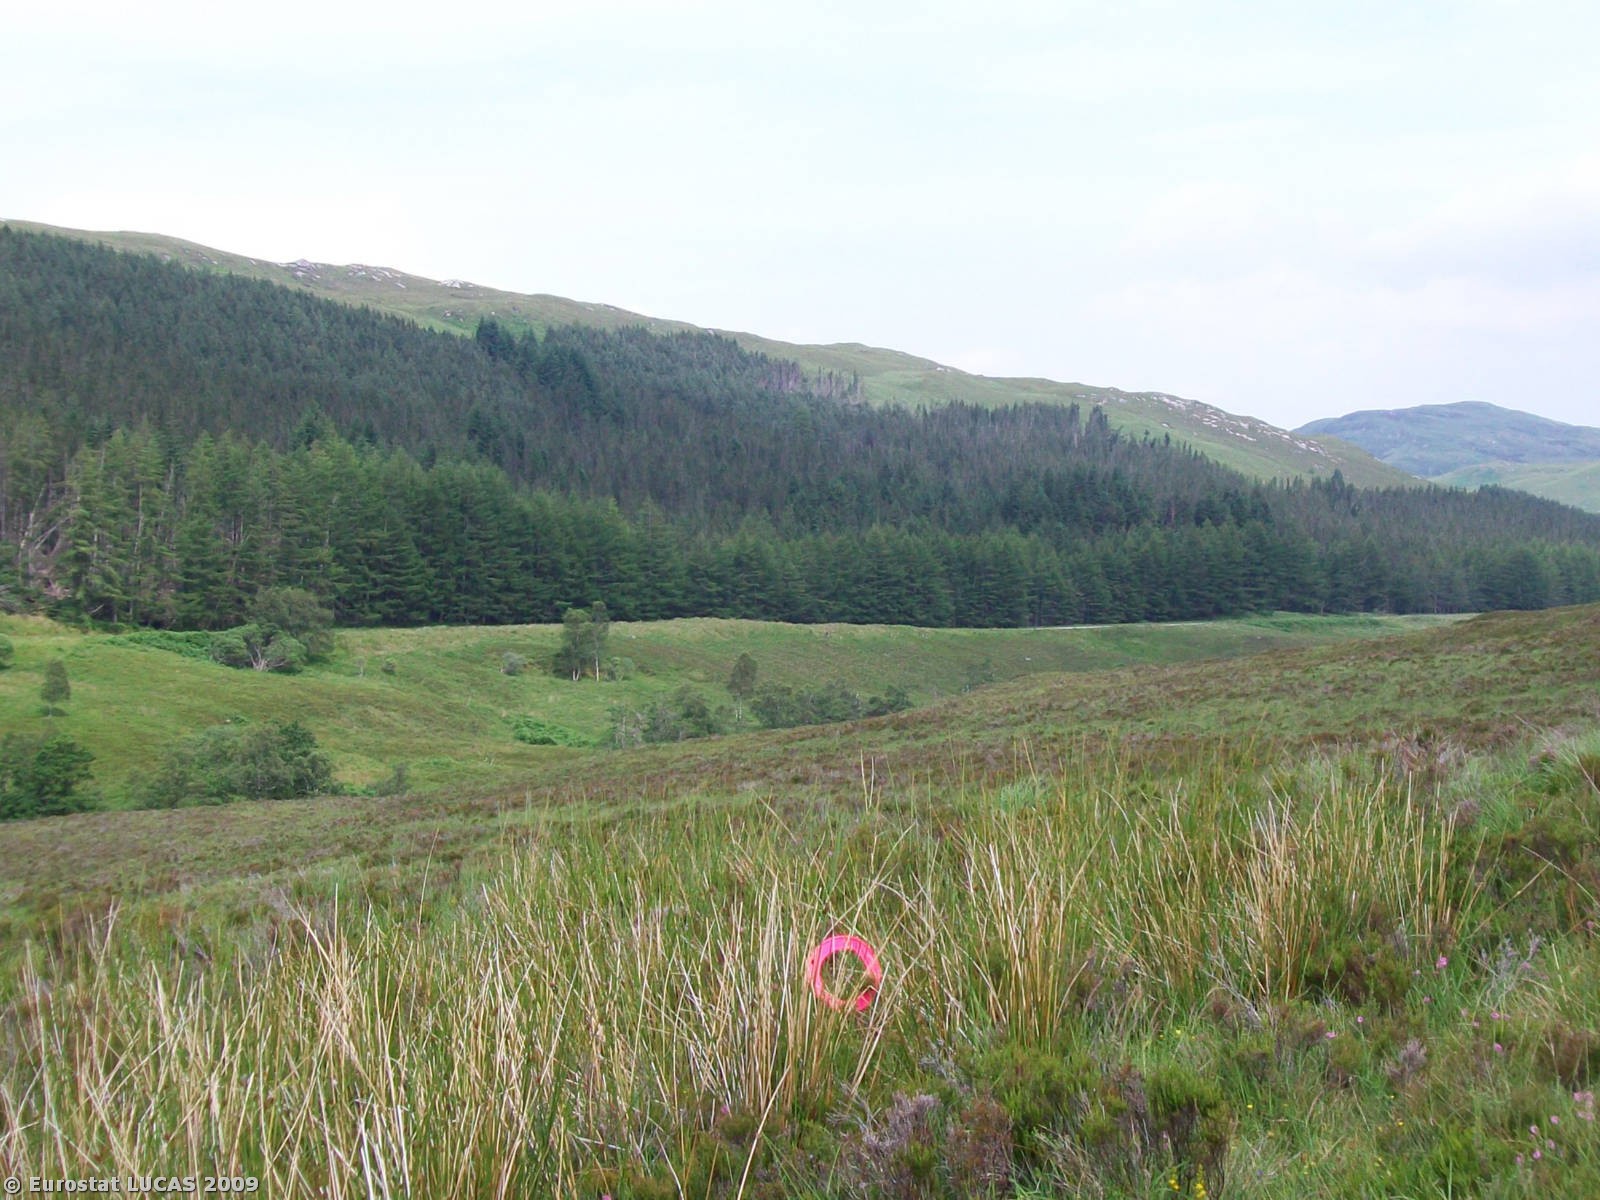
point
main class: Shrubland
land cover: Shrubland without tree cover
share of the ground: > 75 %
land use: Unused
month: July
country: GB
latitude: 57.7925
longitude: -5.1605
